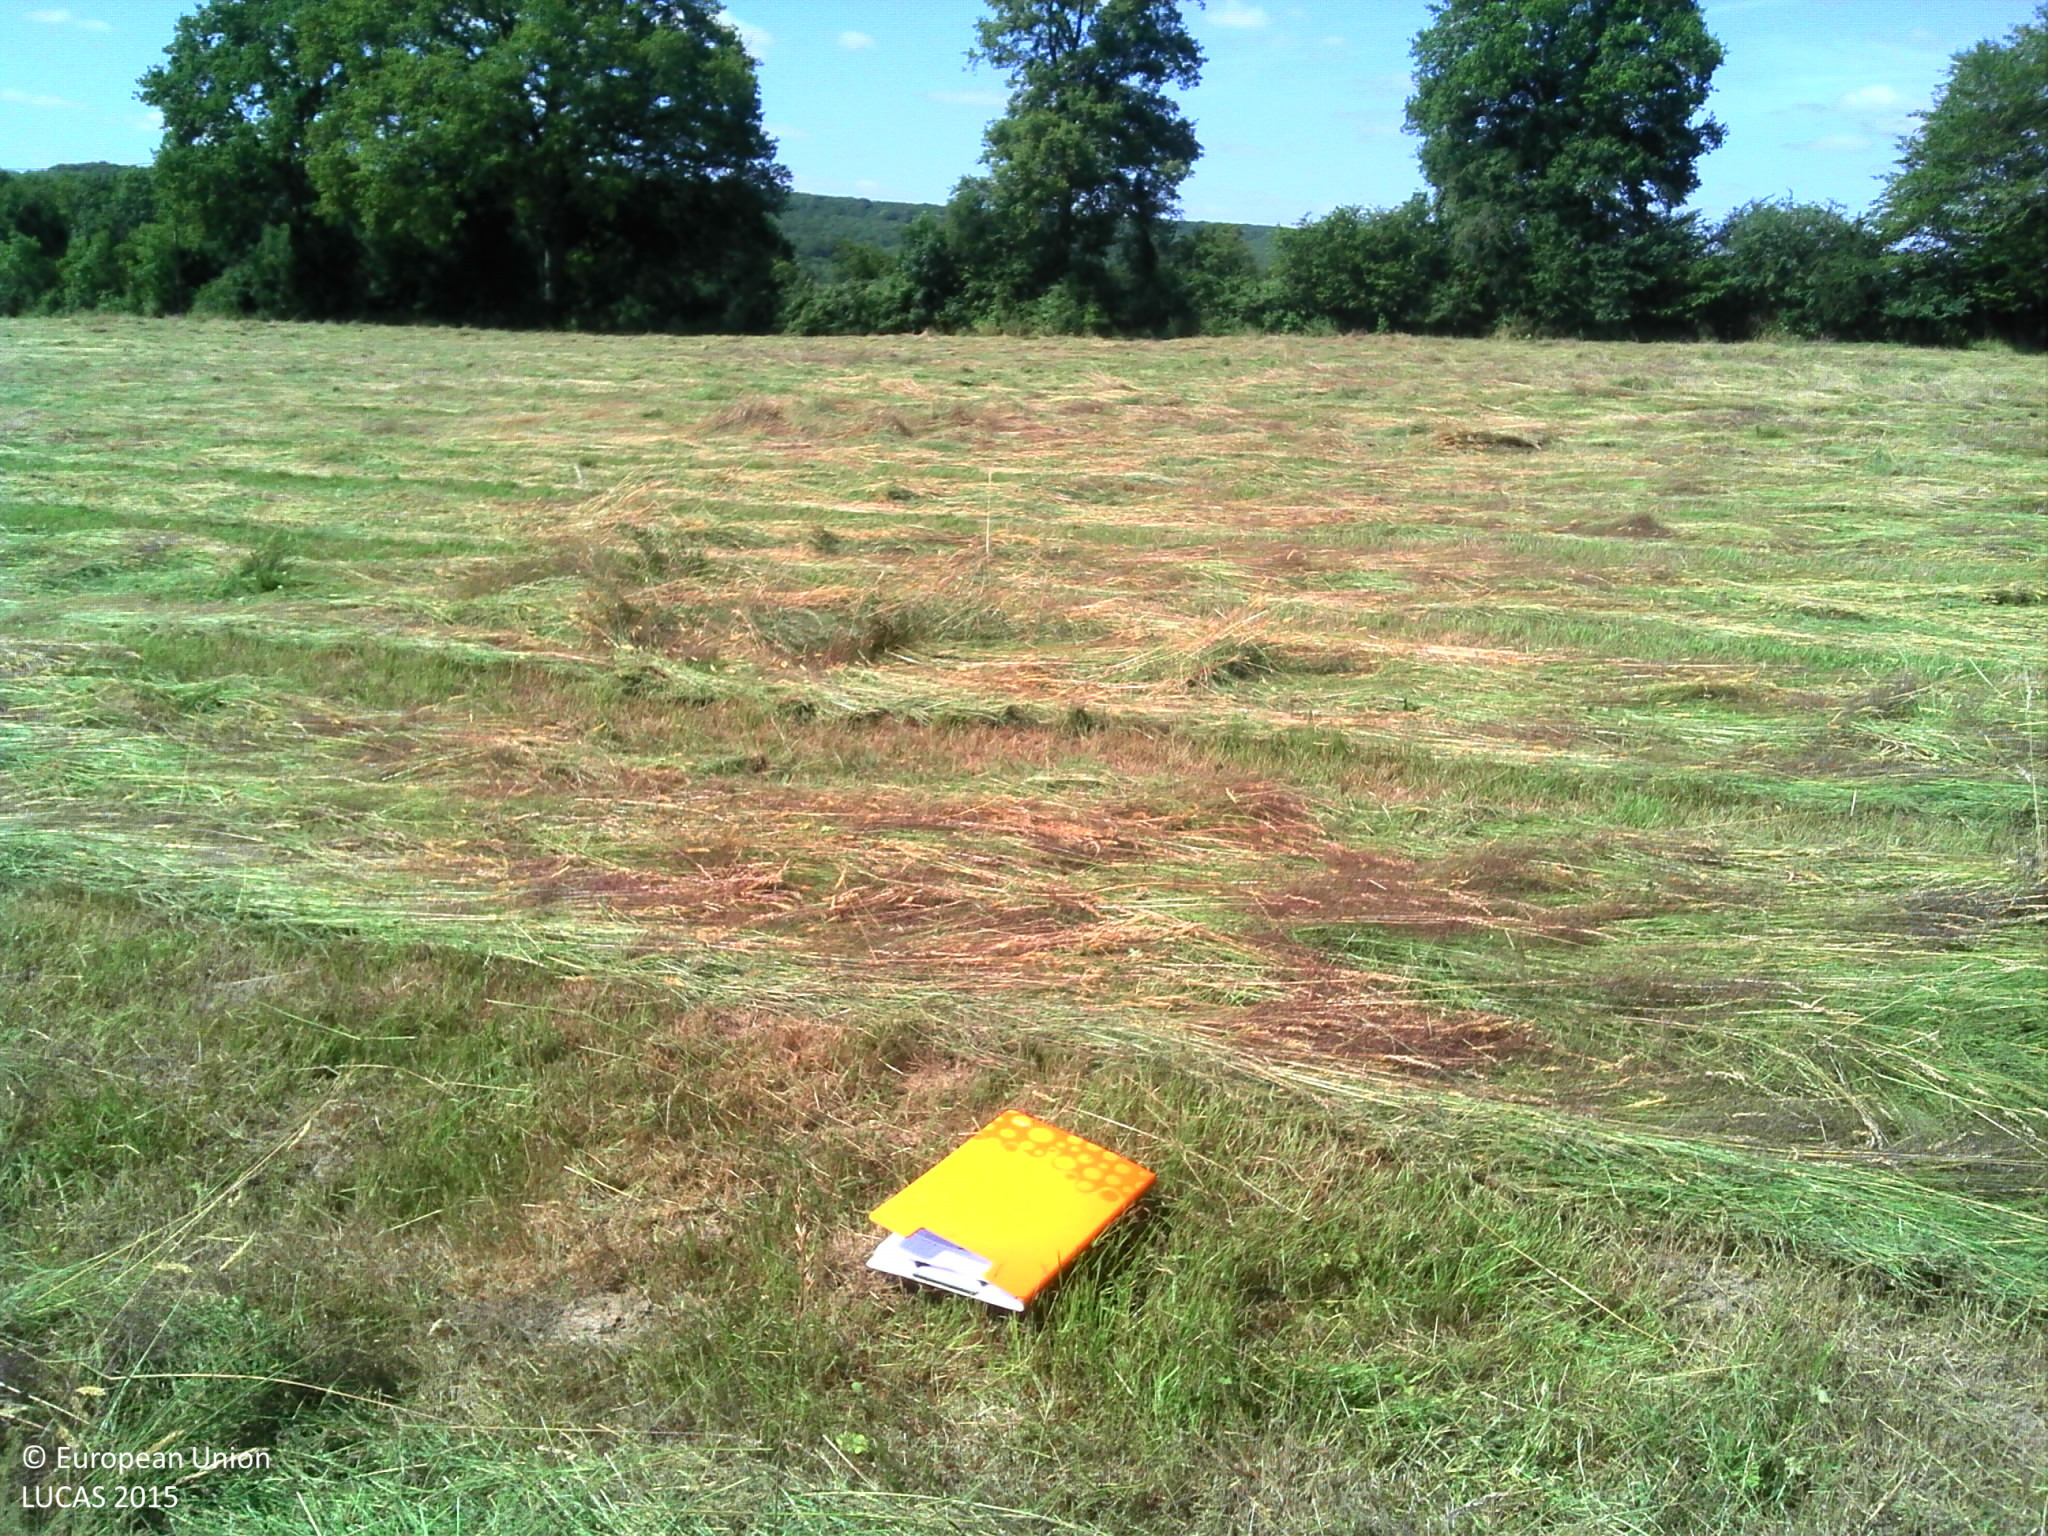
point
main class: Grassland
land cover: Grassland without tree/shrub cover
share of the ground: > 75 %
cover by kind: herbaceous plants 100 %
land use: Agriculture (excluding fallow land and kitchen gardens)
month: June
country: FR
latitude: 47.2684
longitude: 2.5781
